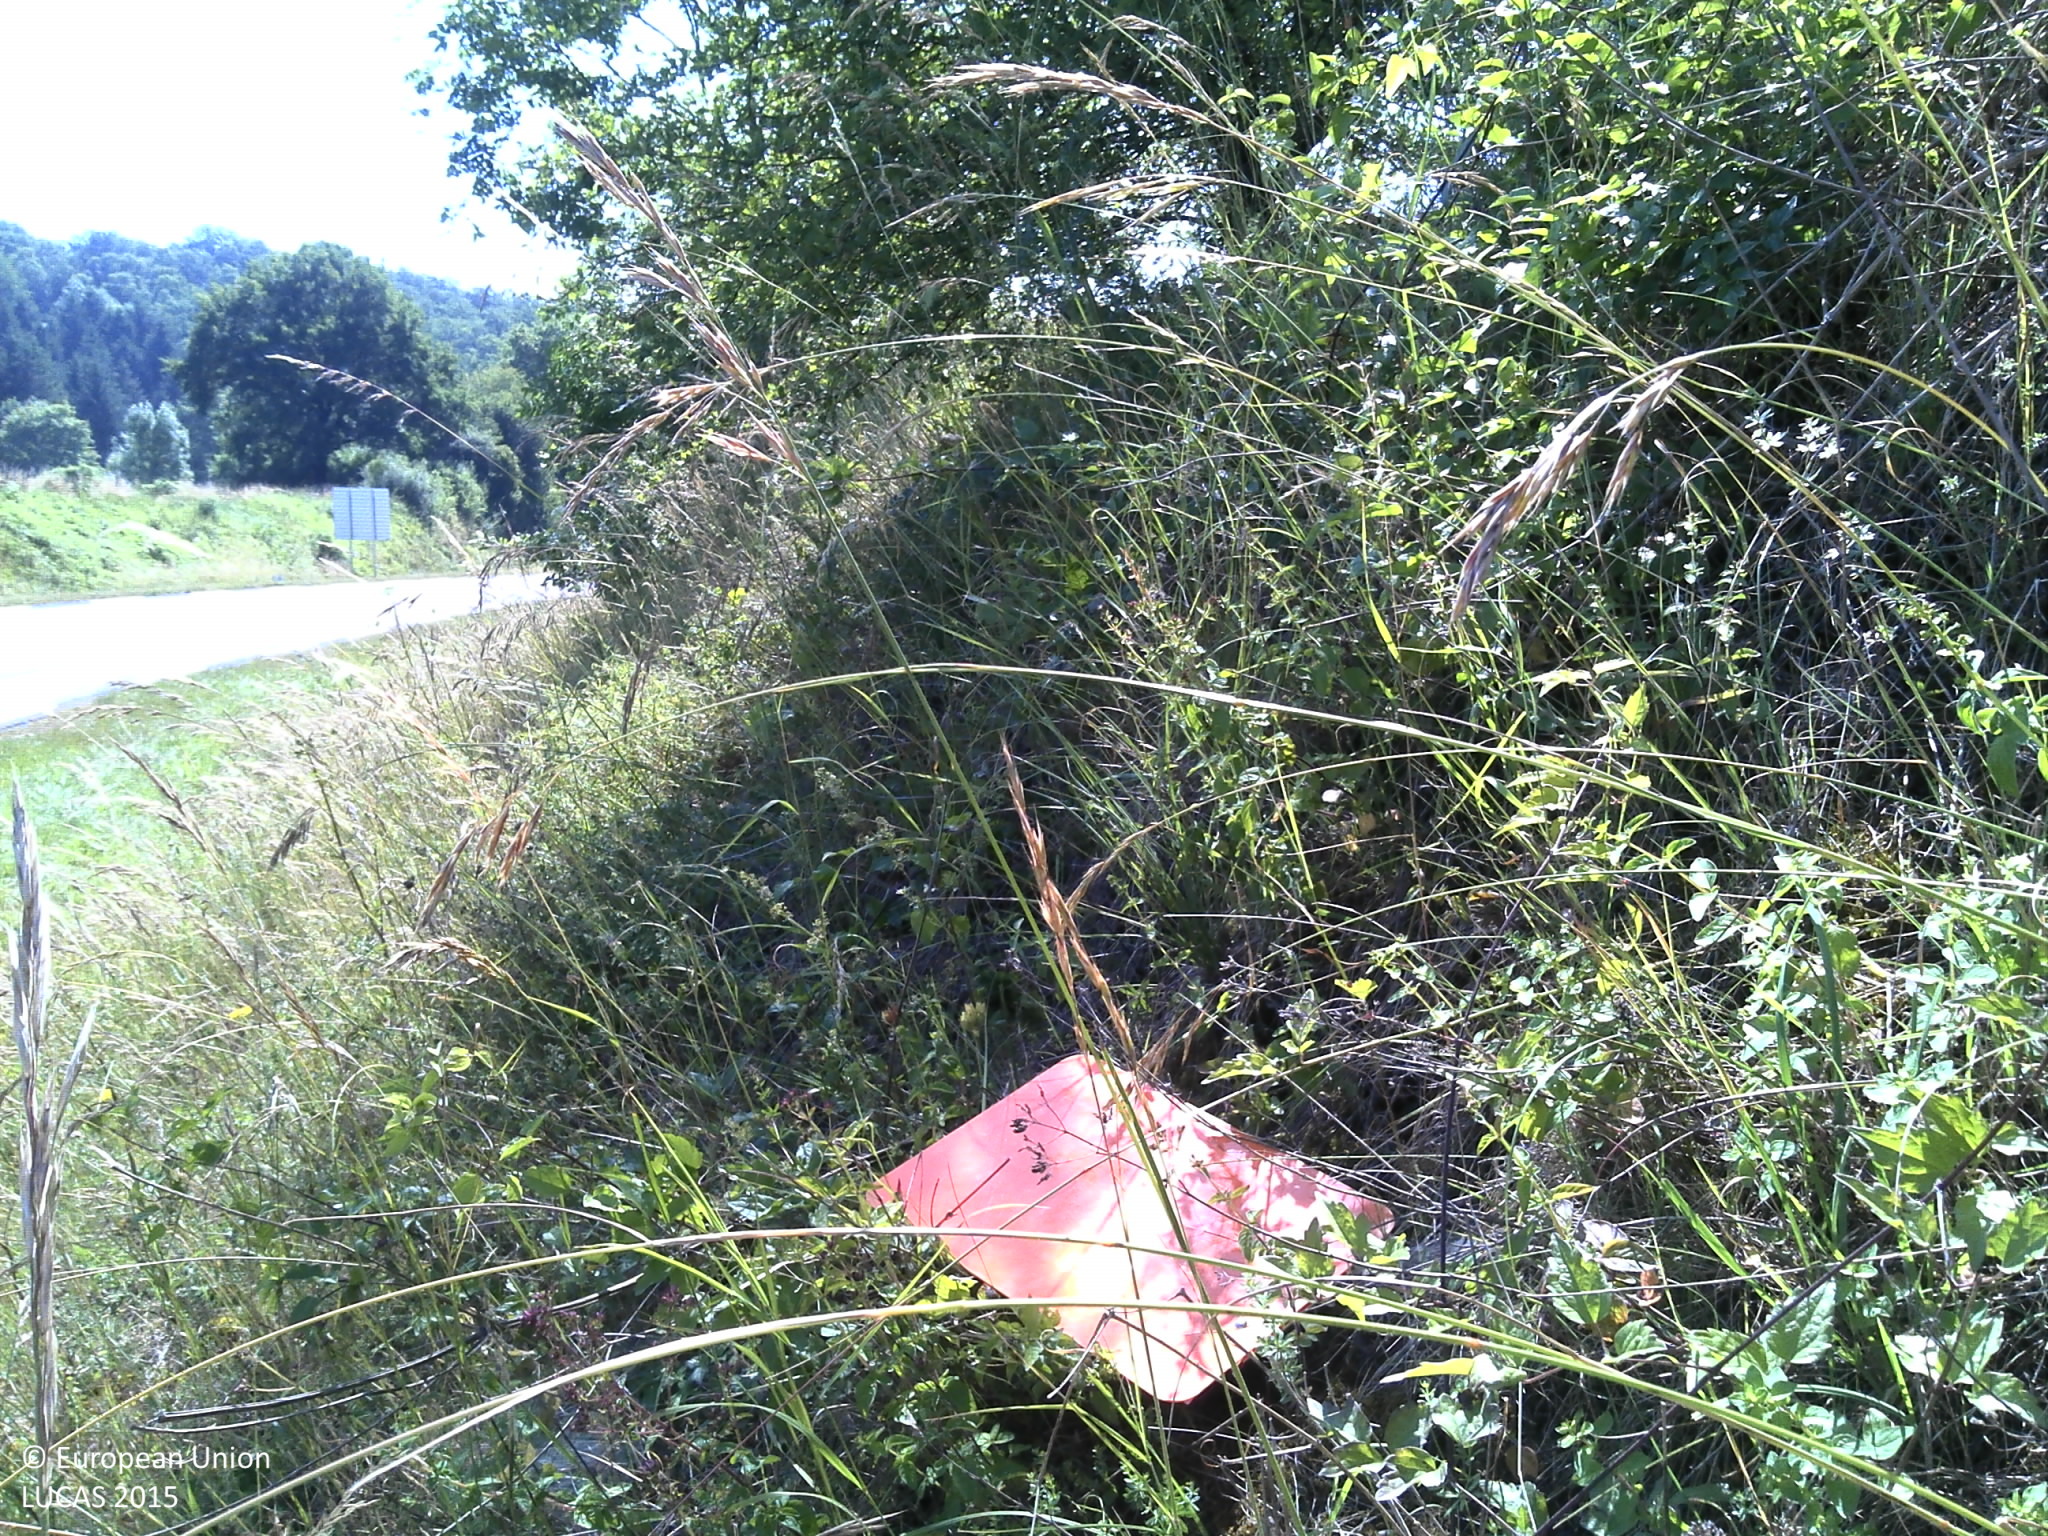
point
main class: Grassland
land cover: Grassland with sparse tree/shrub cover
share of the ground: > 75 %
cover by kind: herbaceous plants 95 %, broadleaved forest trees 5 %
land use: Semi-natural and natural areas not in use
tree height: < 5 m
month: June
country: FR
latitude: 50.1188
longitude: 4.7800
